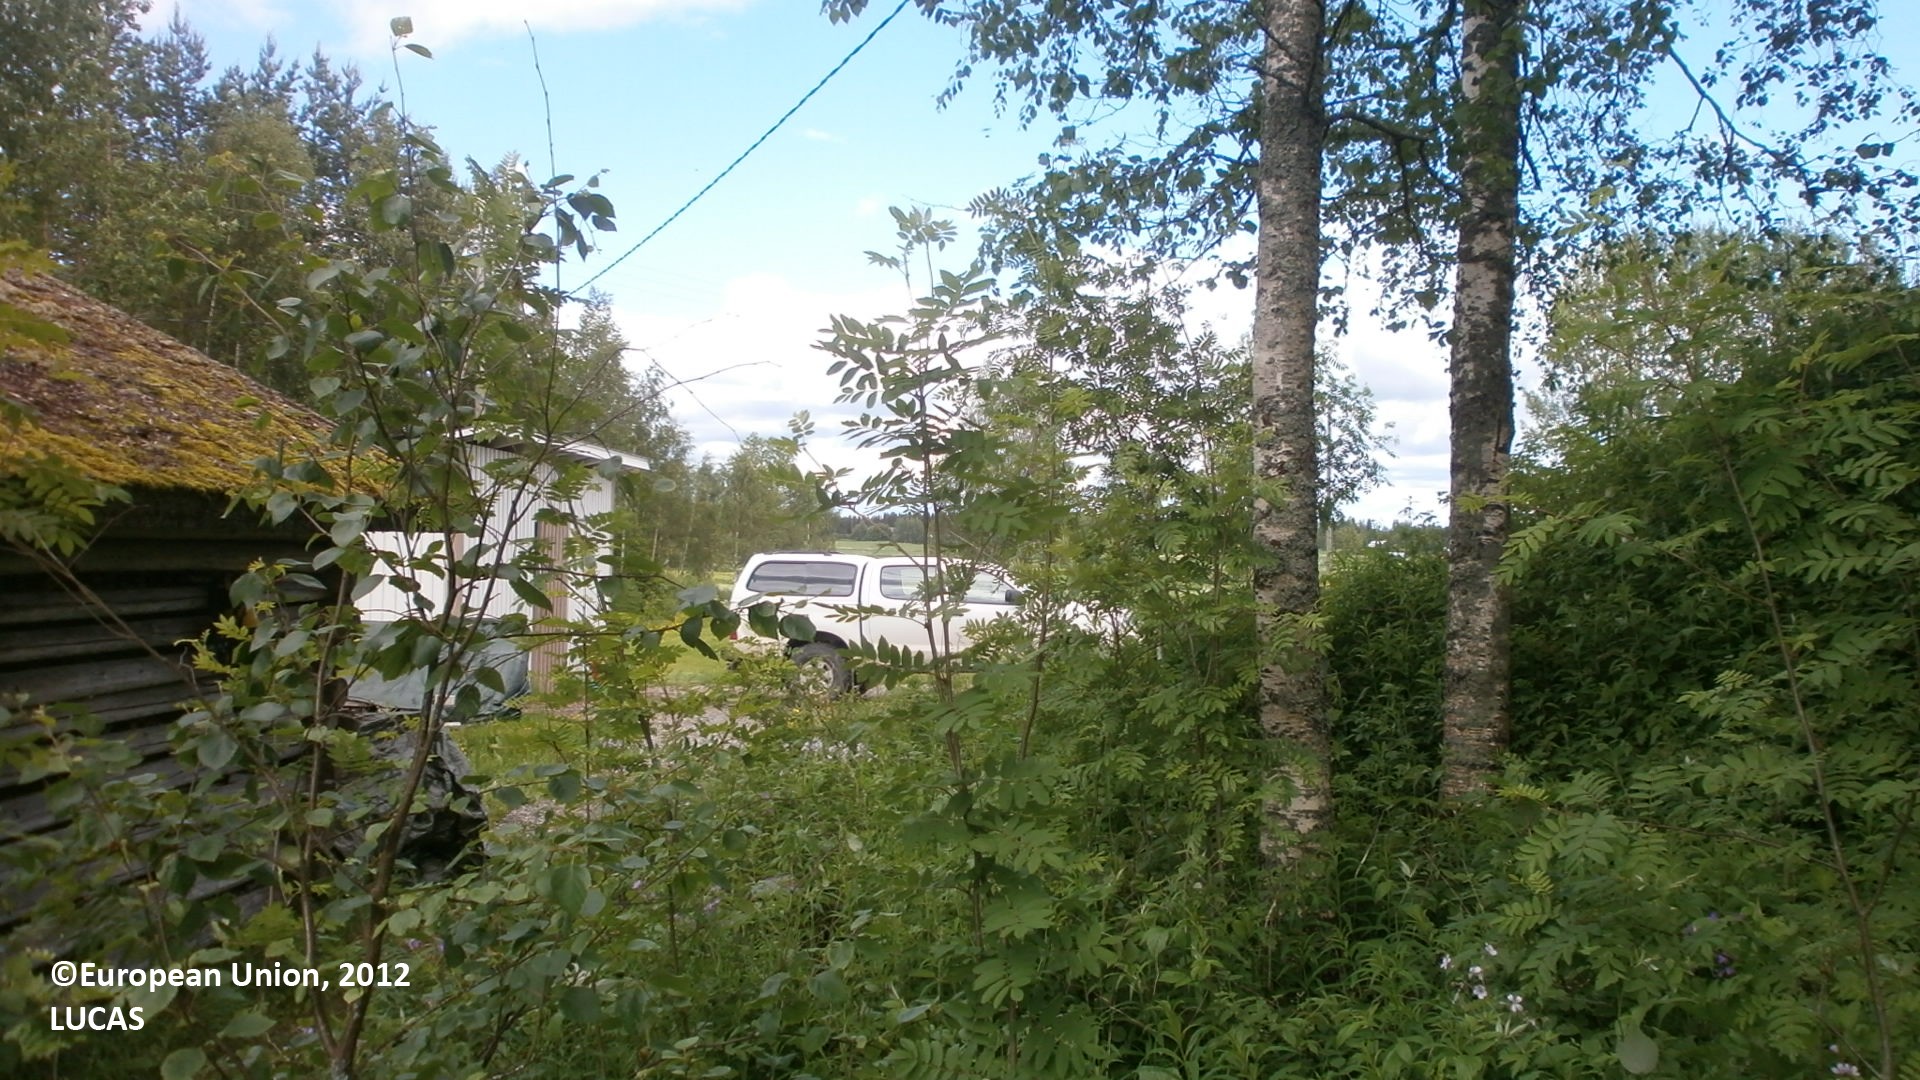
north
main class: Woodland
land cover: Broadleaved woodland
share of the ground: 50 - 75 %
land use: Residential
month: June
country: FI
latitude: 64.2984
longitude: 24.8971
